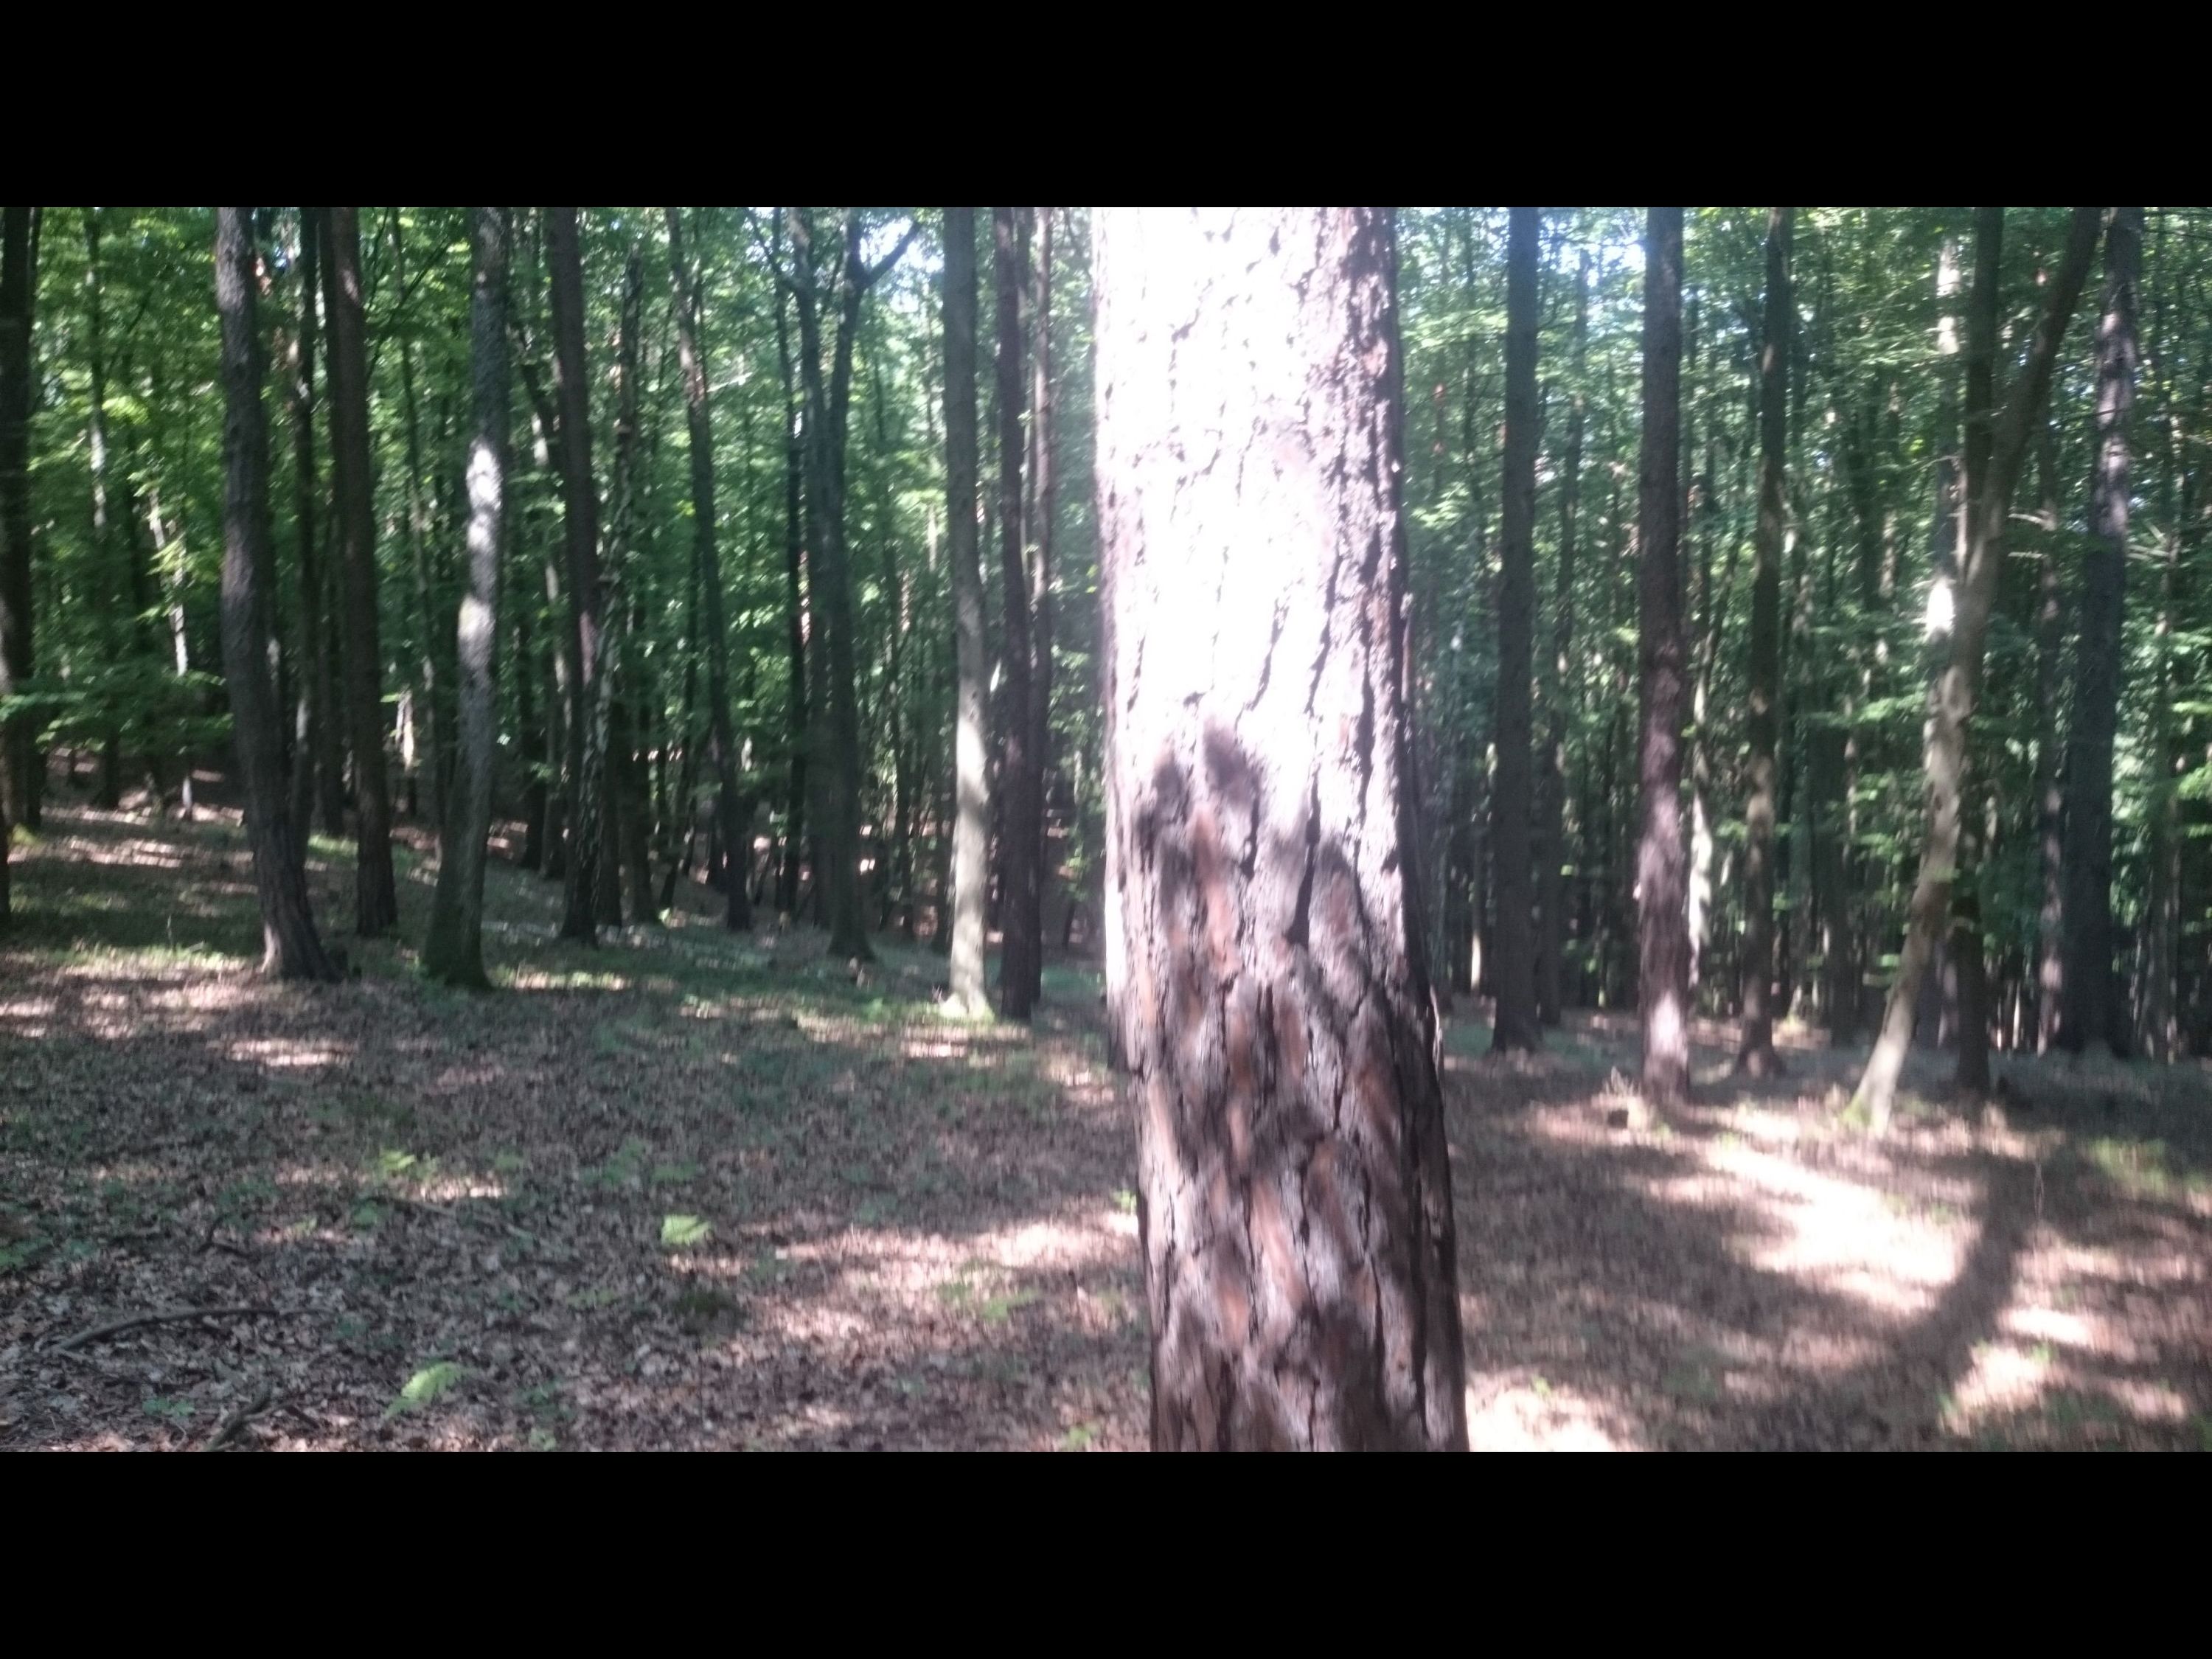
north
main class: Woodland
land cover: Pine dominated mixed woodland
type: hemiboreal forest and nemoral coniferous forest and mixed broadleaved-coniferous forest
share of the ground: > 75 %
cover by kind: coniferous forest trees 50 %, broadleaved forest trees 35 %, unconsolidated bare surface 10 %, herbaceous plants 5 %
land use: Forestry
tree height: > 5 m
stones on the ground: < 10 %
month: July
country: AT
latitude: 47.0155
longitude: 15.9601
